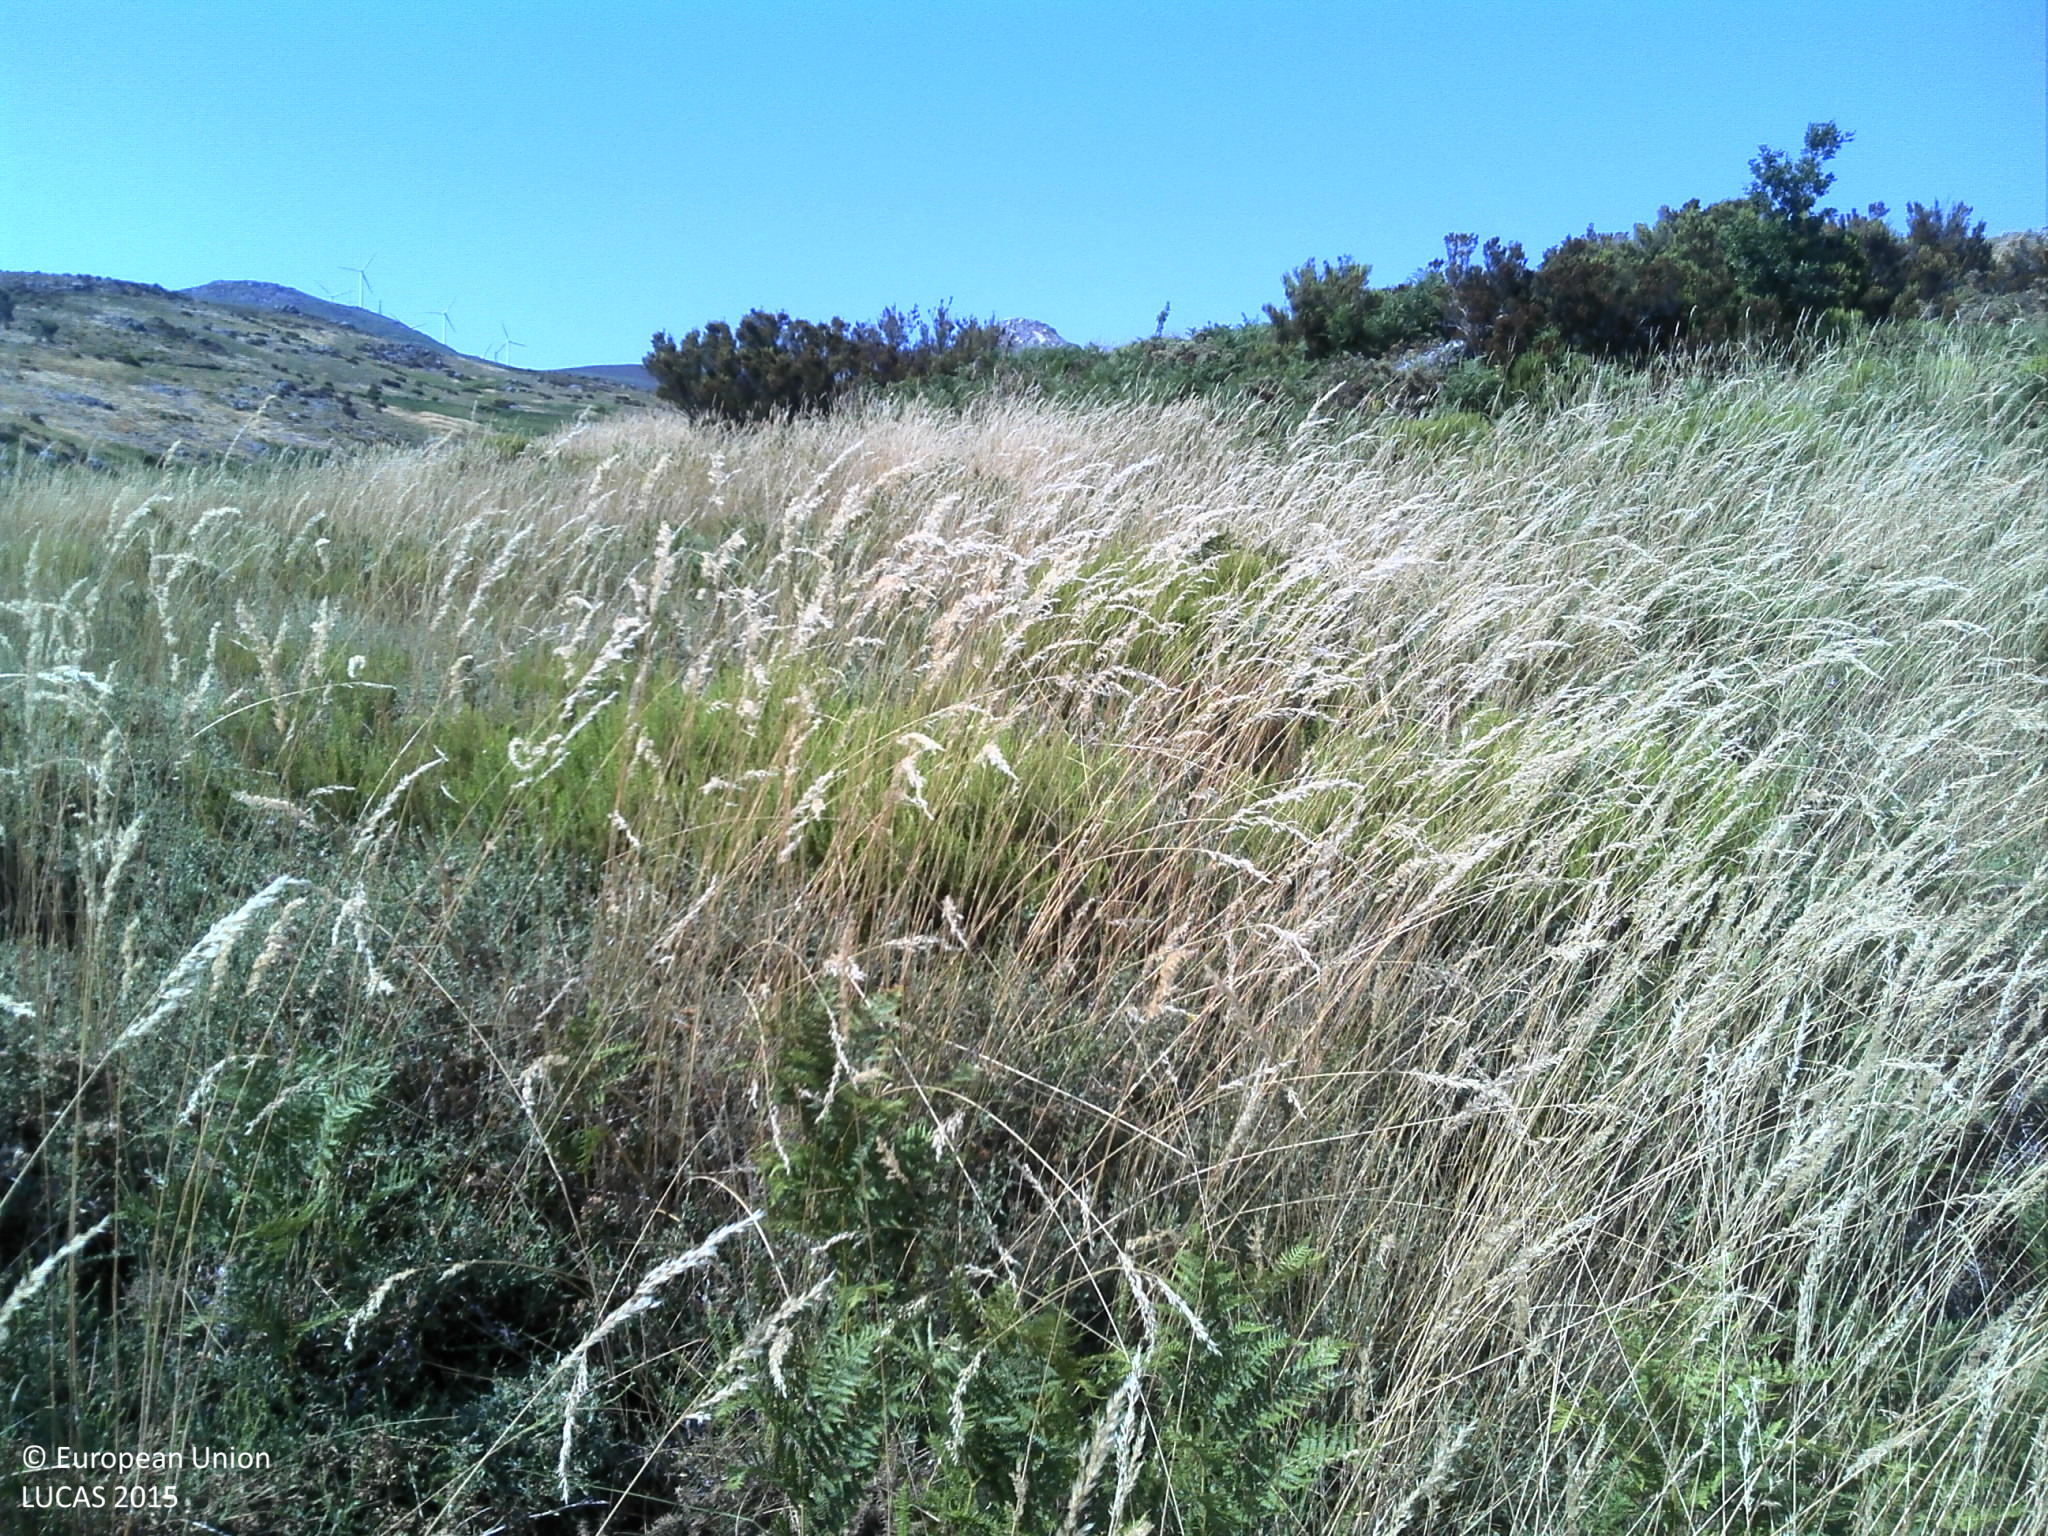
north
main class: Shrubland
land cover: Shrubland without tree cover
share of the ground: 50 - 75 %
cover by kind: shrubs 50 %, herbaceous plants 50 %
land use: Agriculture (excluding fallow land and kitchen gardens)
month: July
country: PT
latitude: 41.8493
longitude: -7.8350
